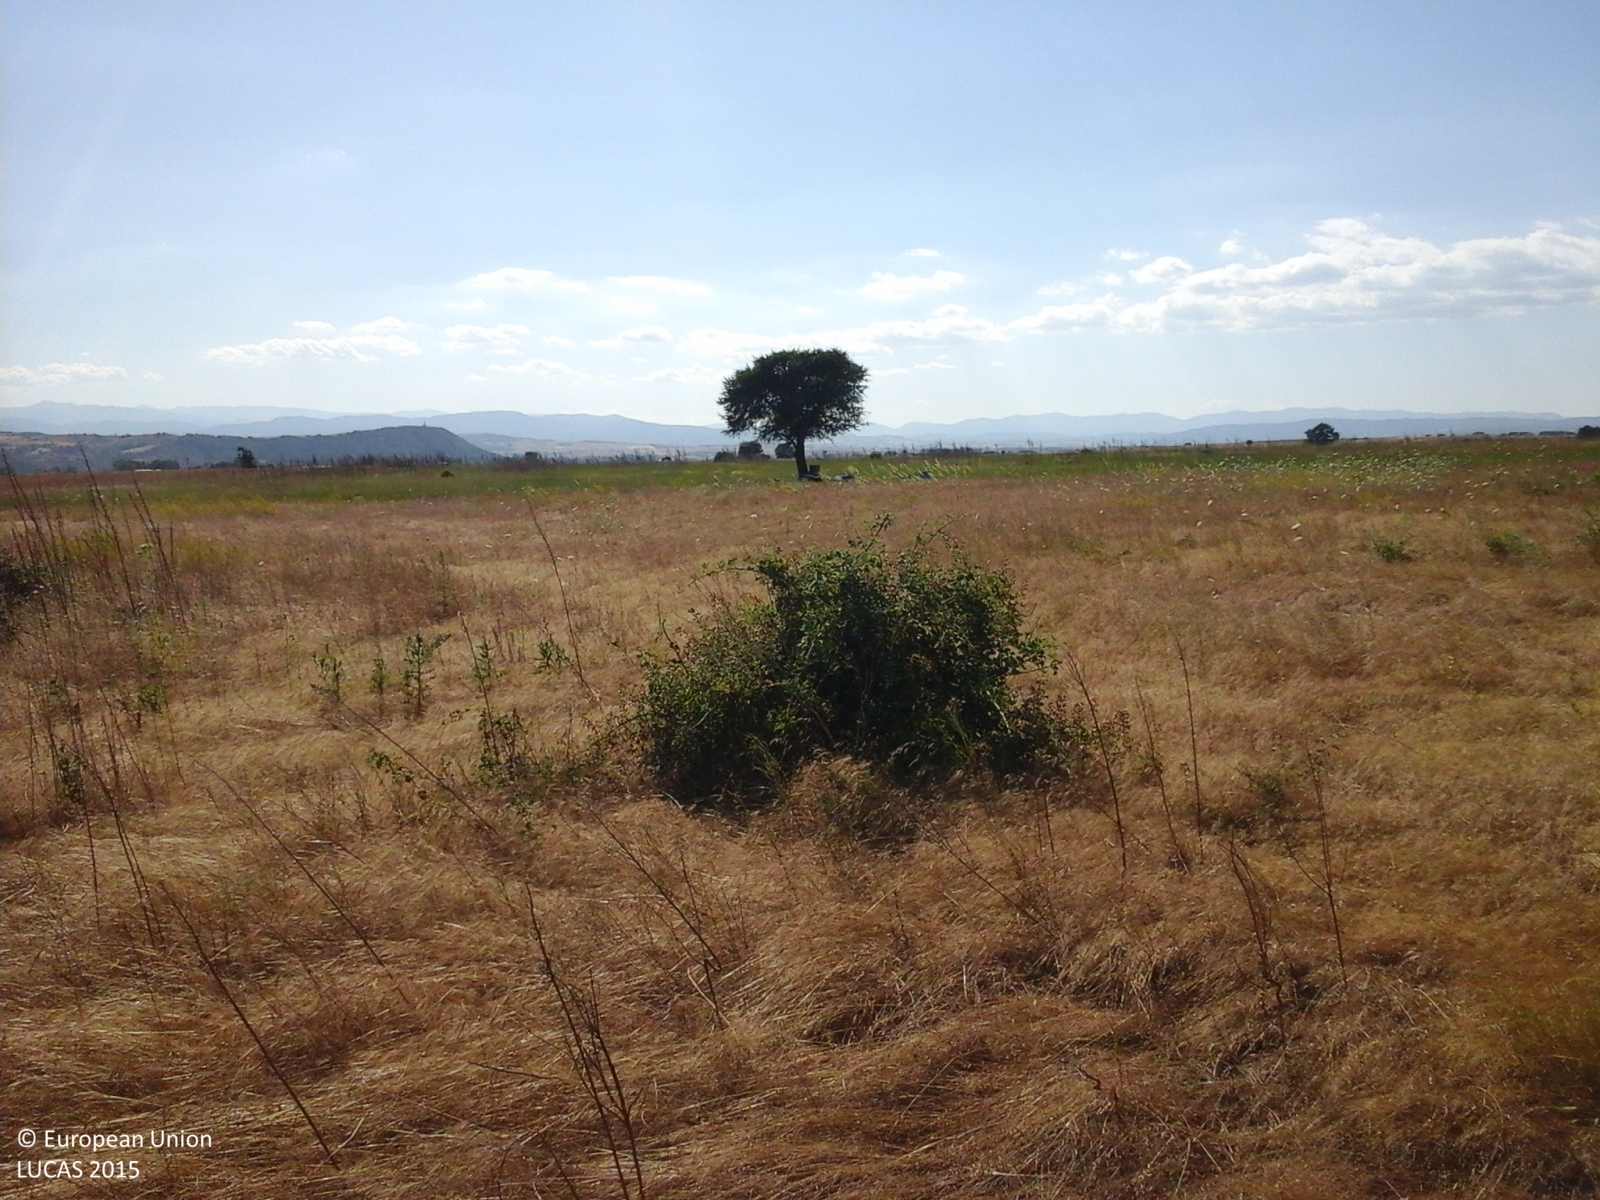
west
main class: Grassland
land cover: Spontaneously vegetated surfaces
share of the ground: > 75 %
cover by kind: herbaceous plants 95 %, shrubs 5 %
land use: Fallow land
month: July
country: GR
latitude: 40.4520
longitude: 21.2975
